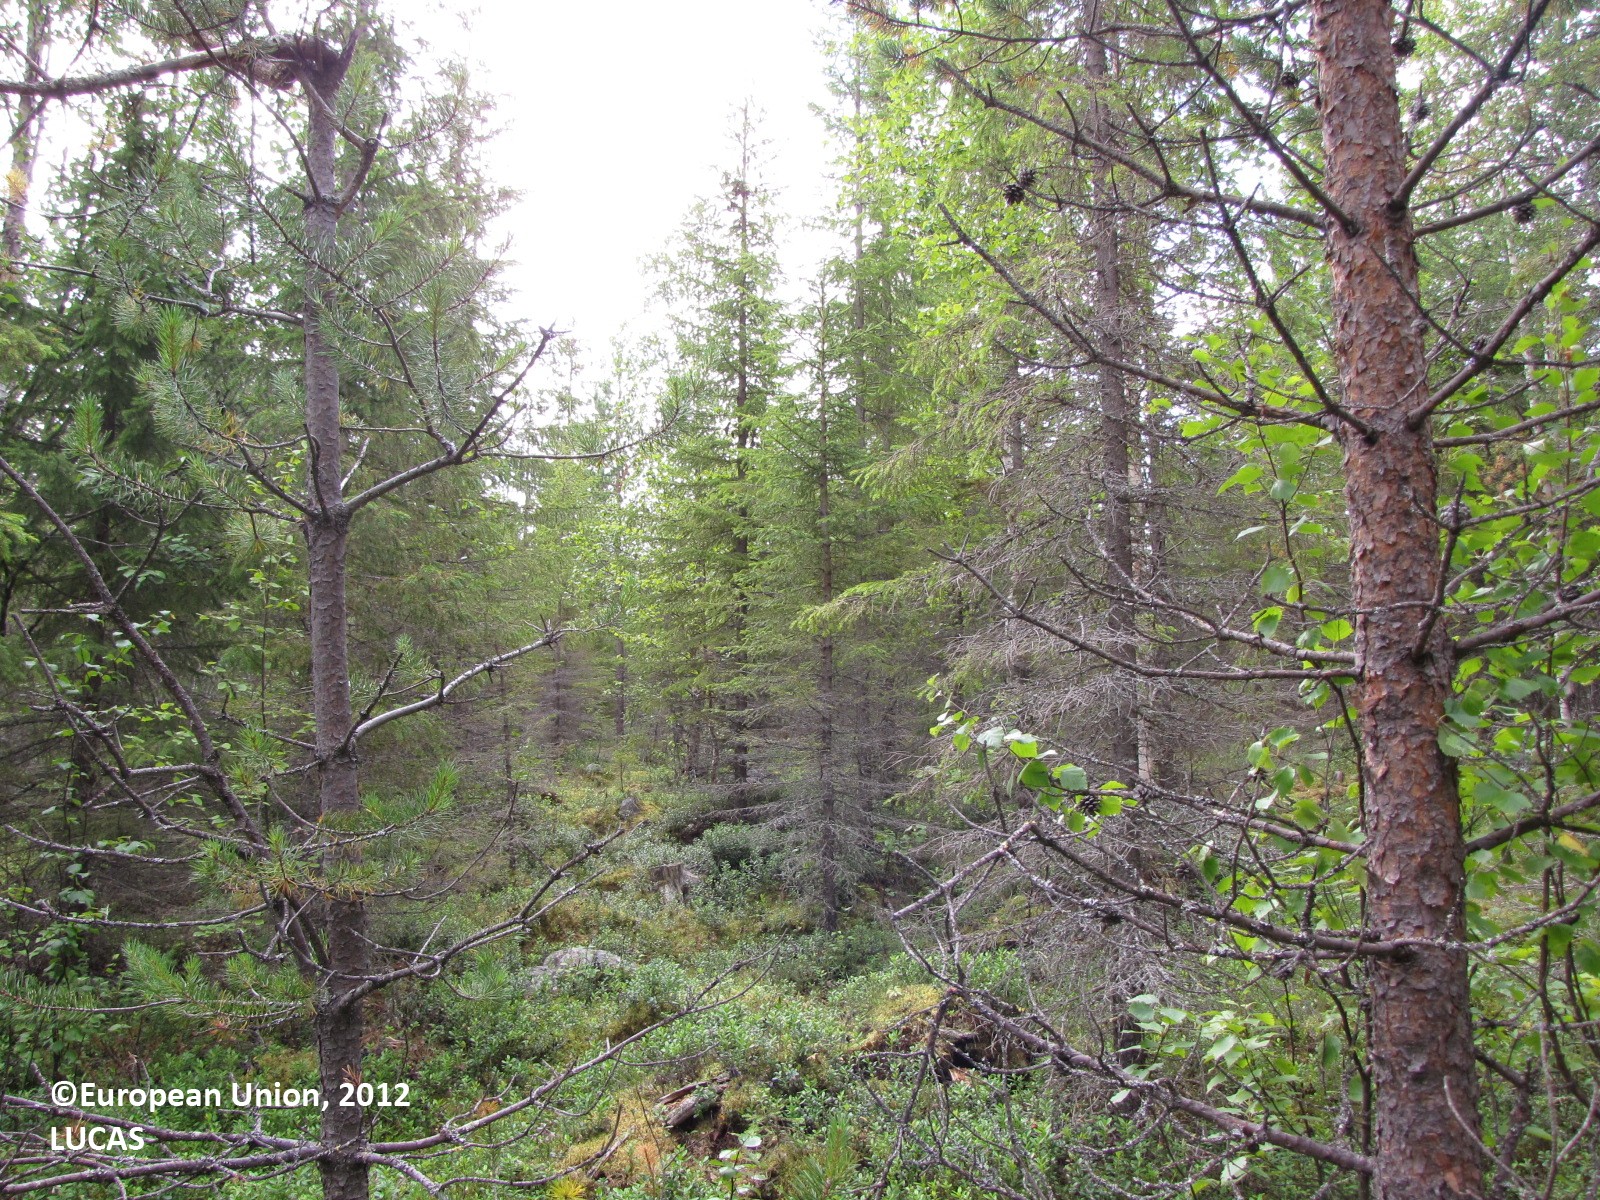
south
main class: Woodland
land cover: Spruce dominated coniferous woodland
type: boreal forest
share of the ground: 25 - 50 %
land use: Forestry
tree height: > 5 m
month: August
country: FI
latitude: 66.8385
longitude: 24.6005
